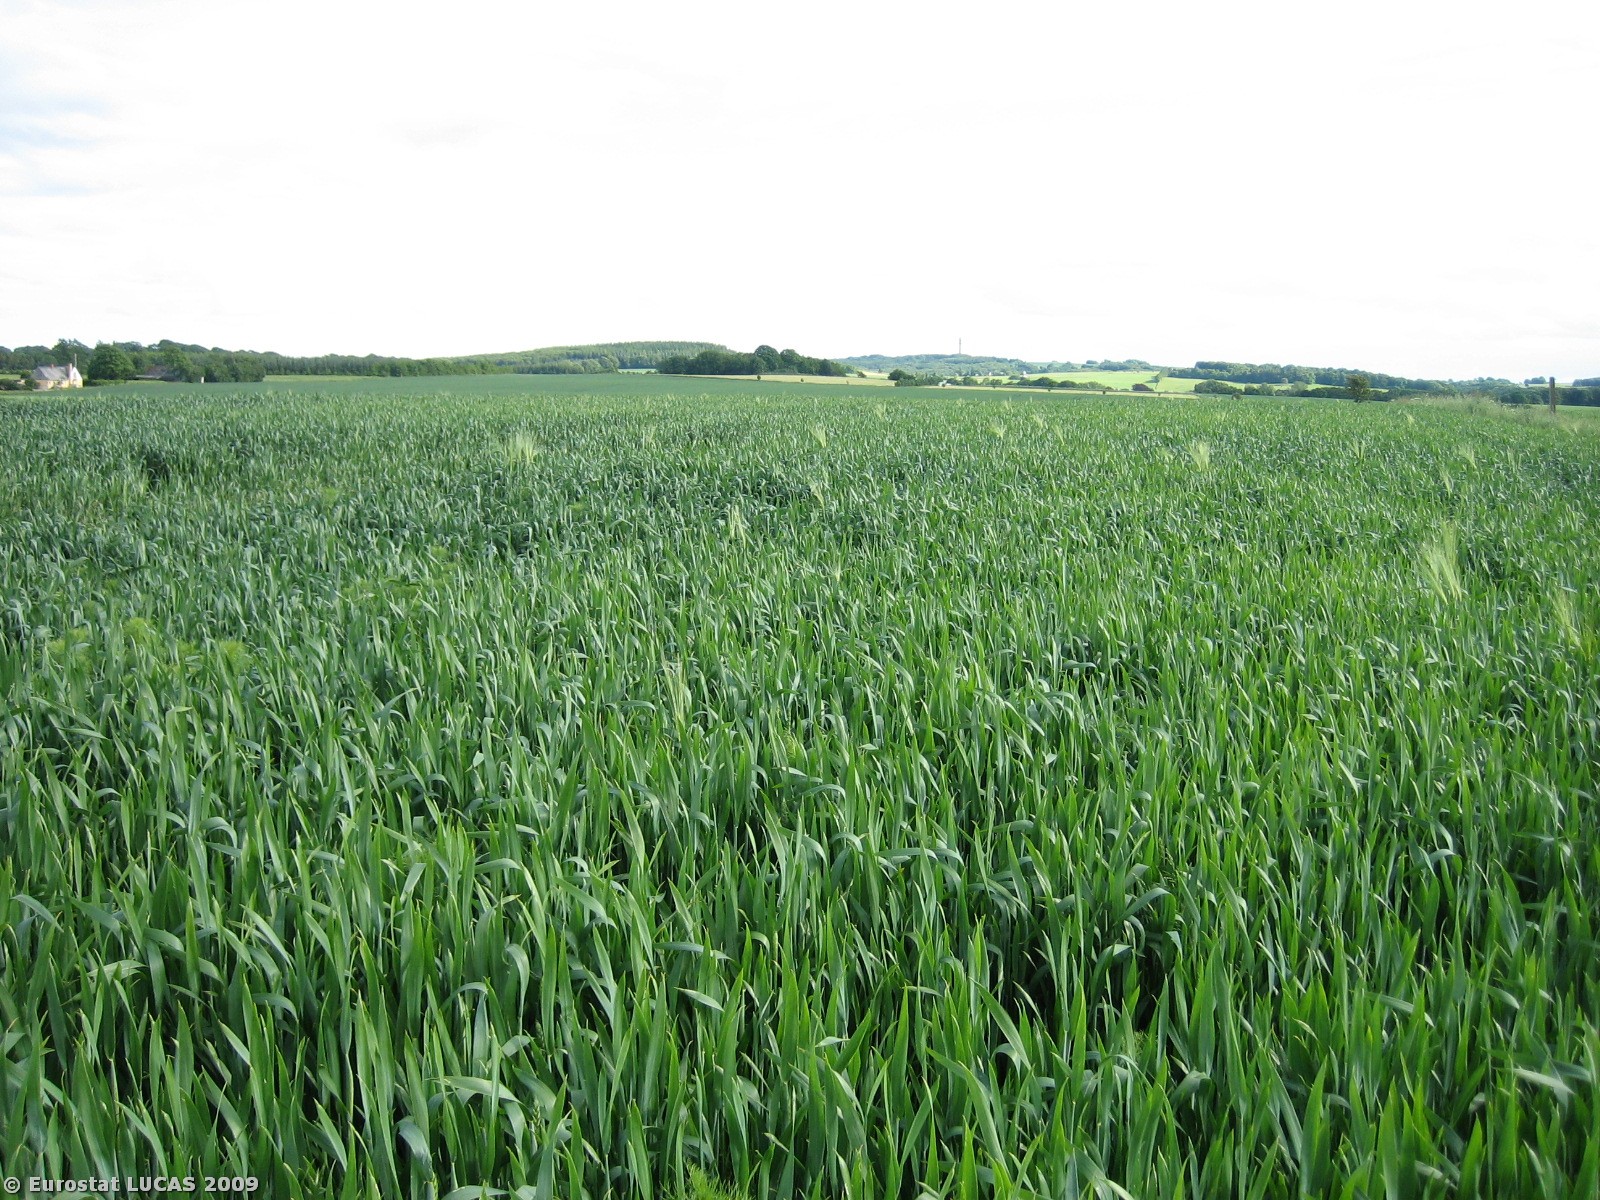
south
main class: Cropland
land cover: Common wheat
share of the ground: > 75 %
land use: Agriculture (excluding fallow land and kitchen gardens)
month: June
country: DK
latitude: 56.2235
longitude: 9.7906
